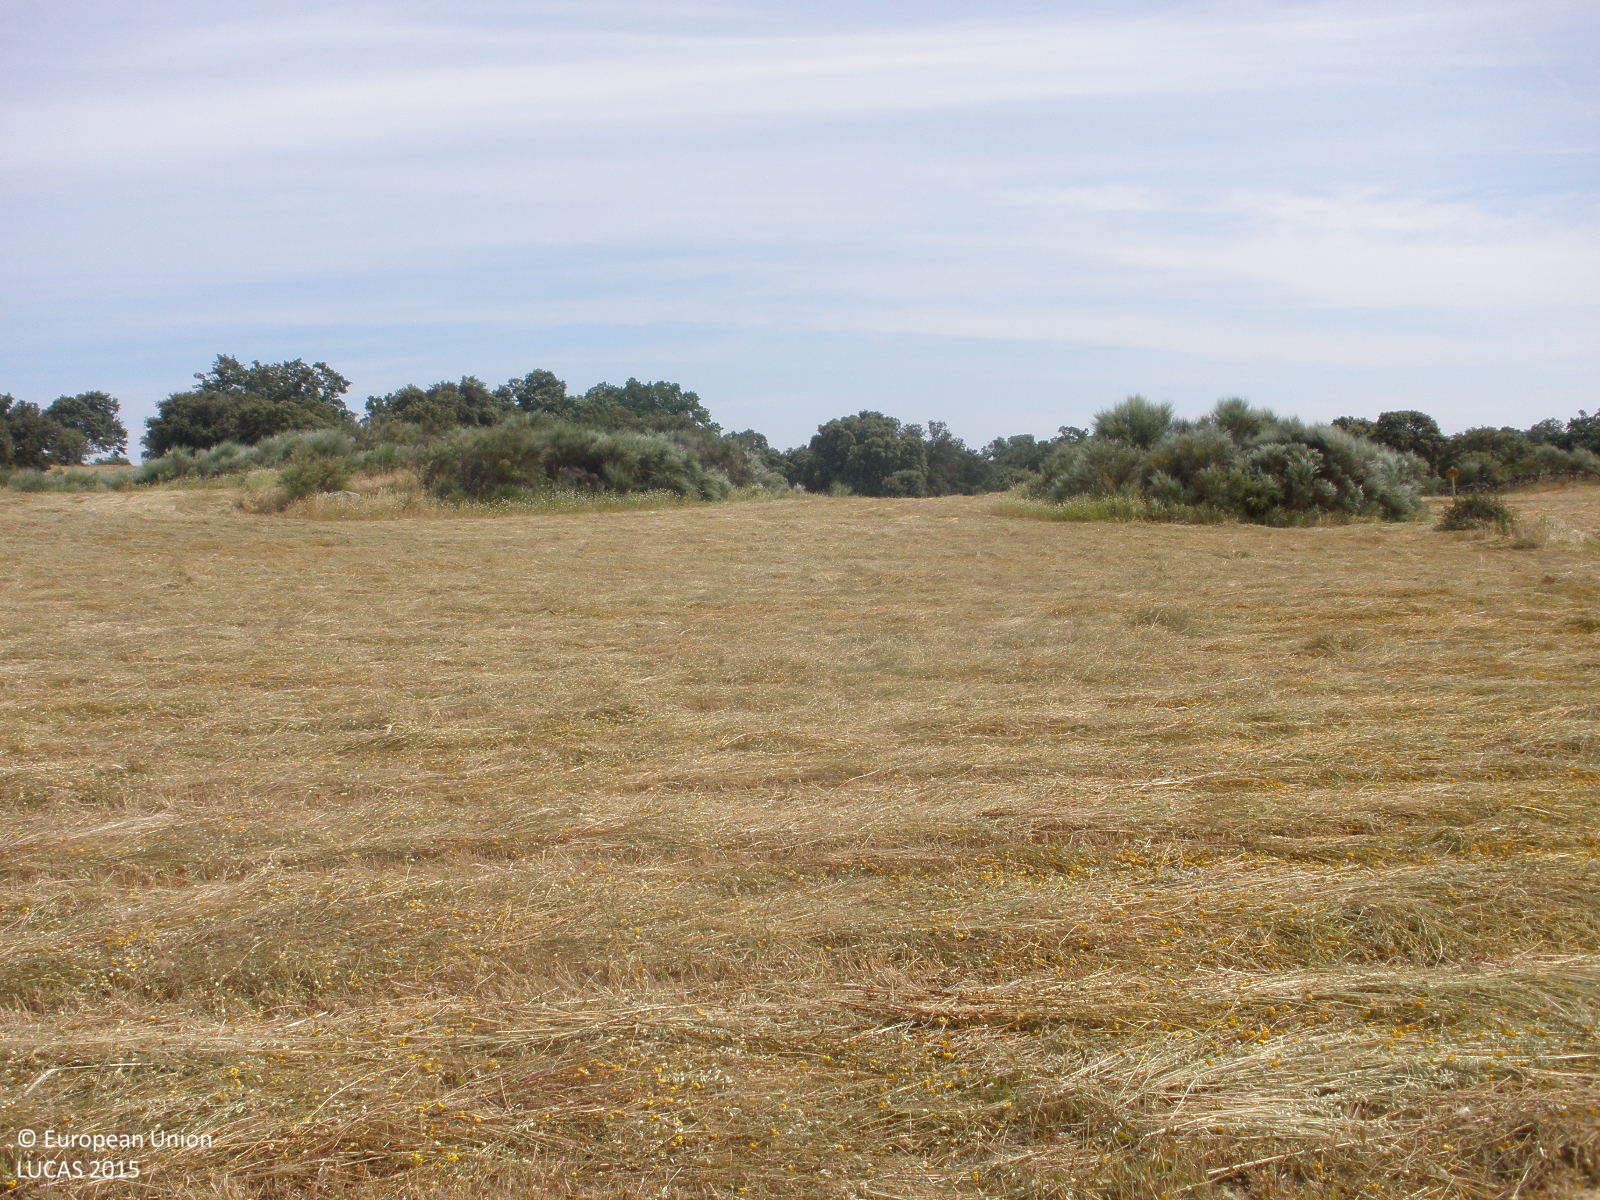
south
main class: Cropland
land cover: Oats
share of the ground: > 75 %
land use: Agriculture (excluding fallow land and kitchen gardens)
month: May
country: ES
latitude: 40.1636
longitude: -6.6284
